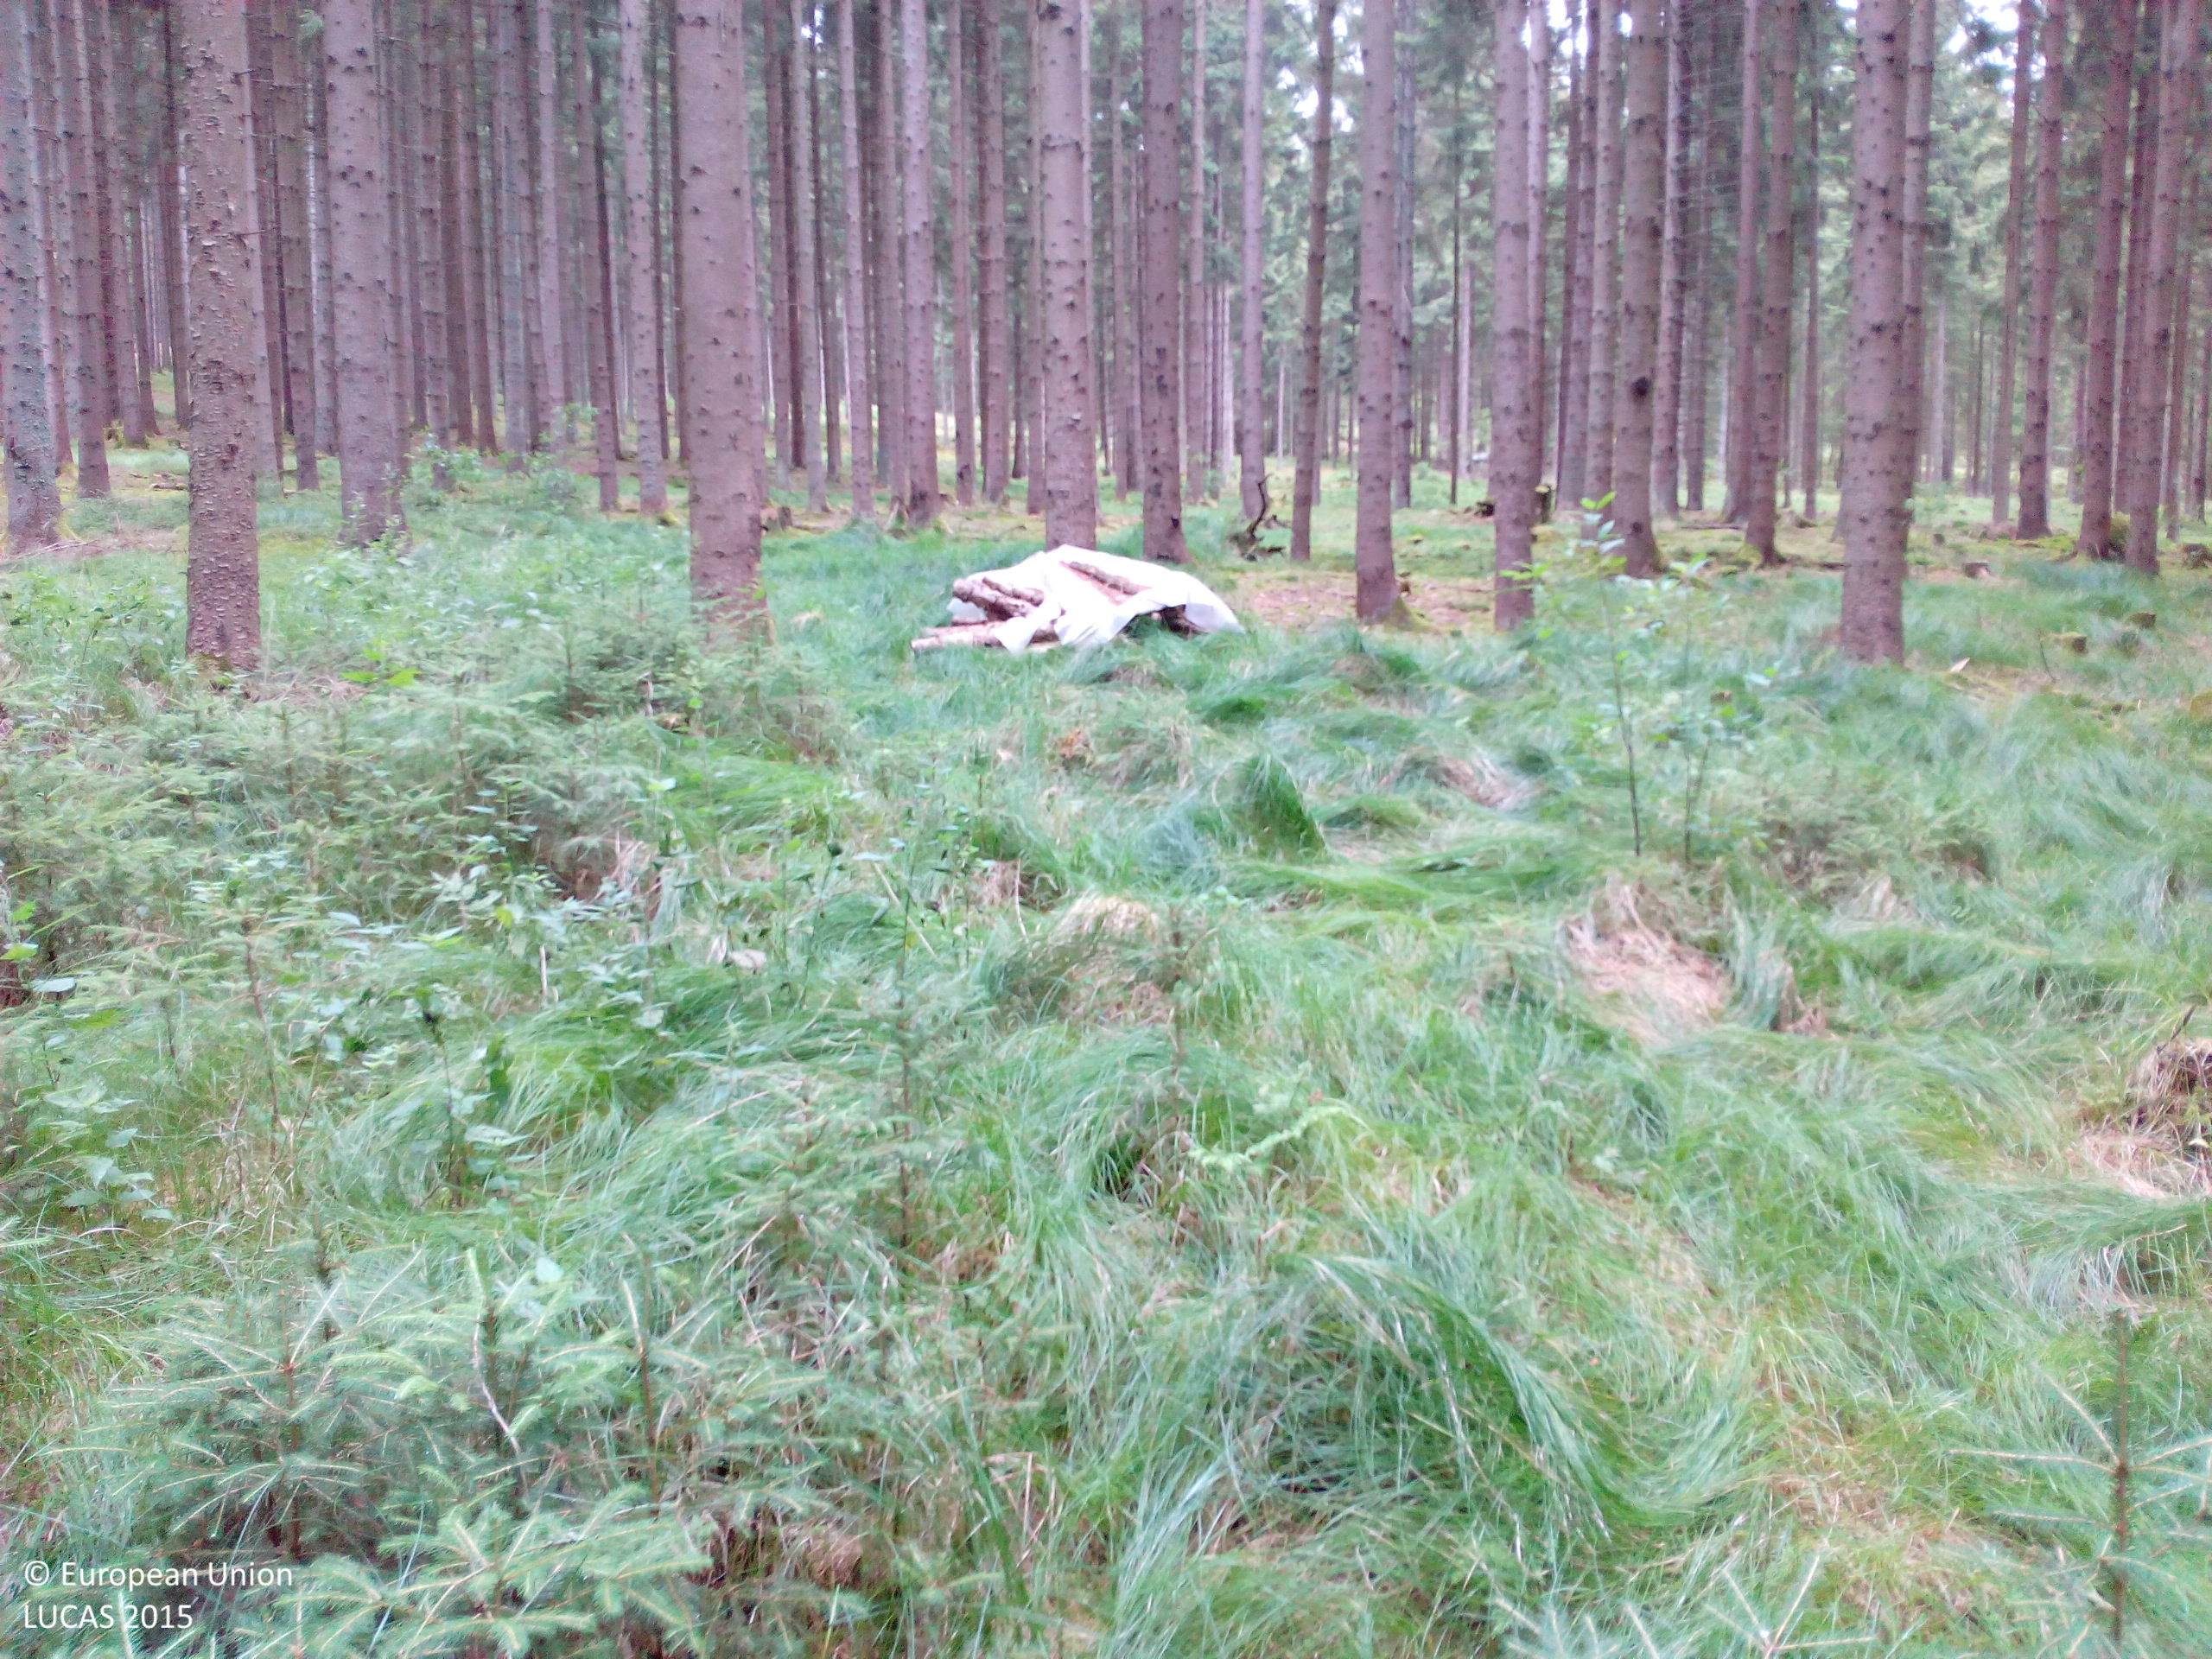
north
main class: Woodland
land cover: Spruce dominated coniferous woodland
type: hemiboreal forest and nemoral coniferous forest and mixed broadleaved-coniferous forest
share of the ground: 50 - 75 %
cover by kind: coniferous forest trees 70 %, herbaceous plants 30 %
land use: Forestry
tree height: > 5 m
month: July
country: DE
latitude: 49.1017
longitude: 12.9718
